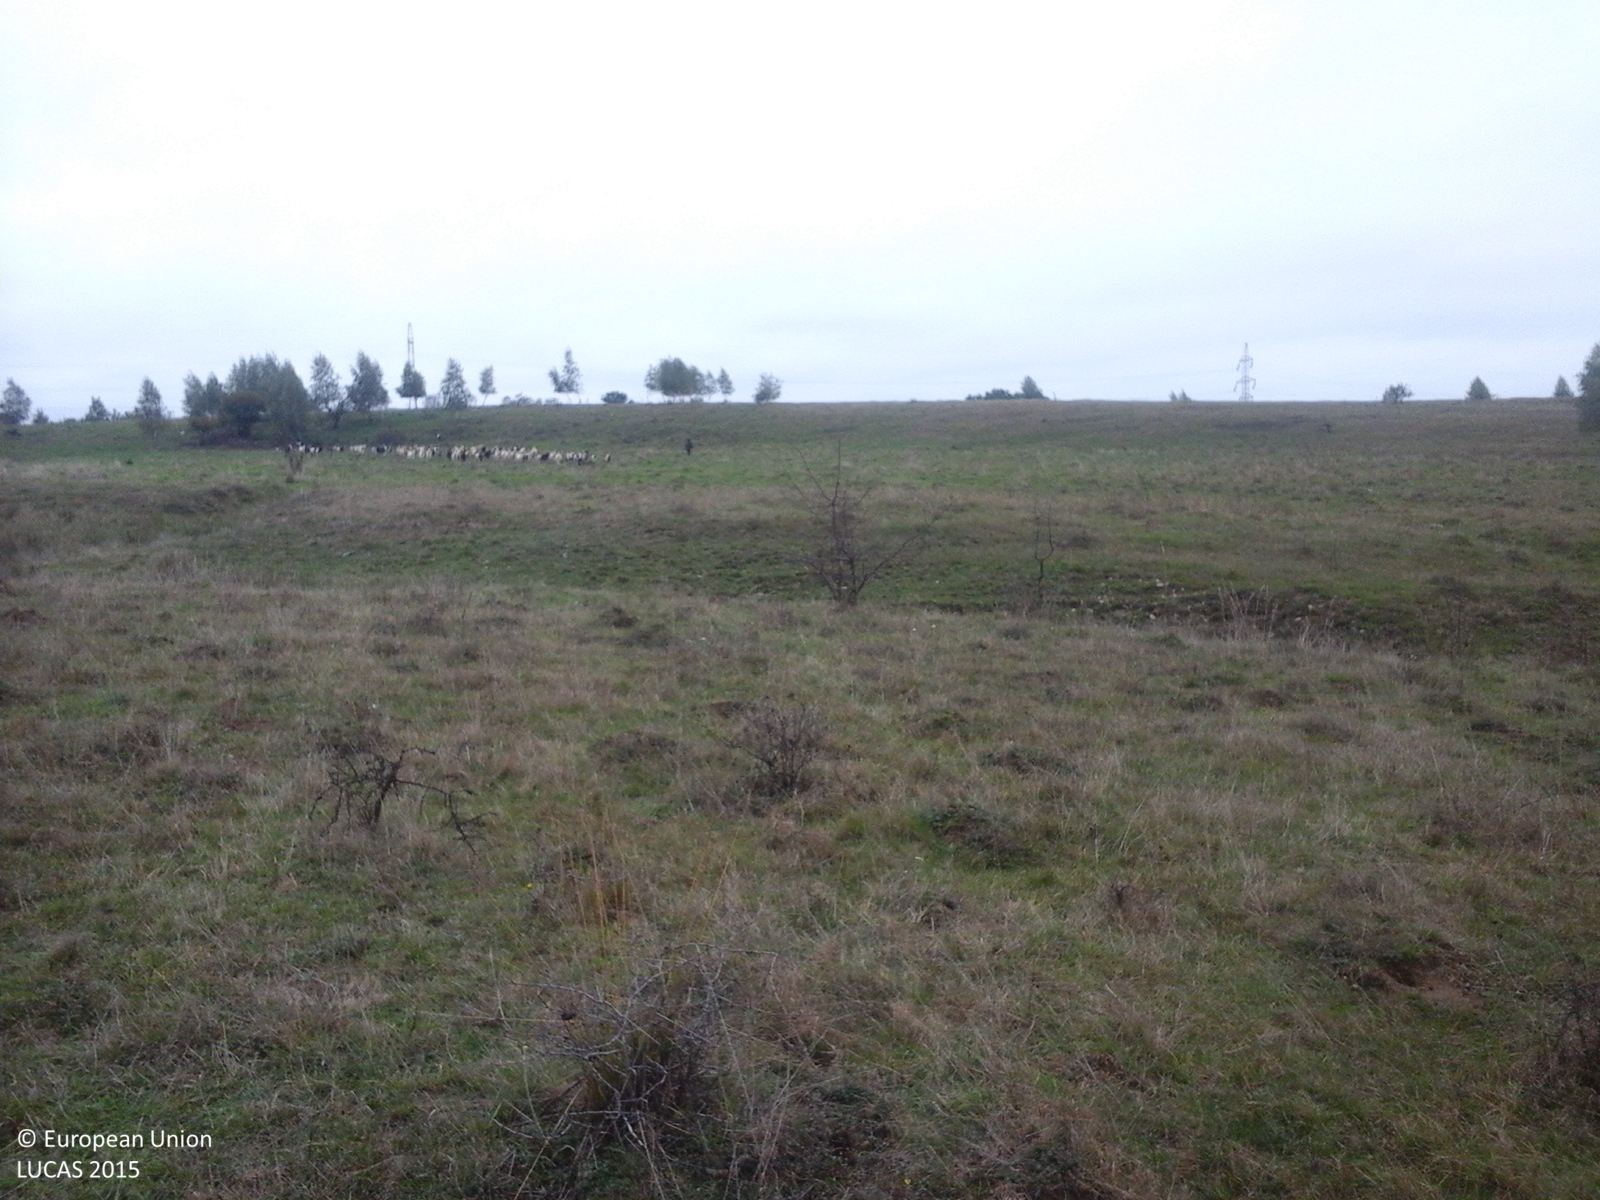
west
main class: Grassland
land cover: Grassland without tree/shrub cover
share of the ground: > 75 %
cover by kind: herbaceous plants 100 %
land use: Agriculture (excluding fallow land and kitchen gardens)
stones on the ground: < 10 %
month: October
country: RO
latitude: 45.7494
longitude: 24.7011
